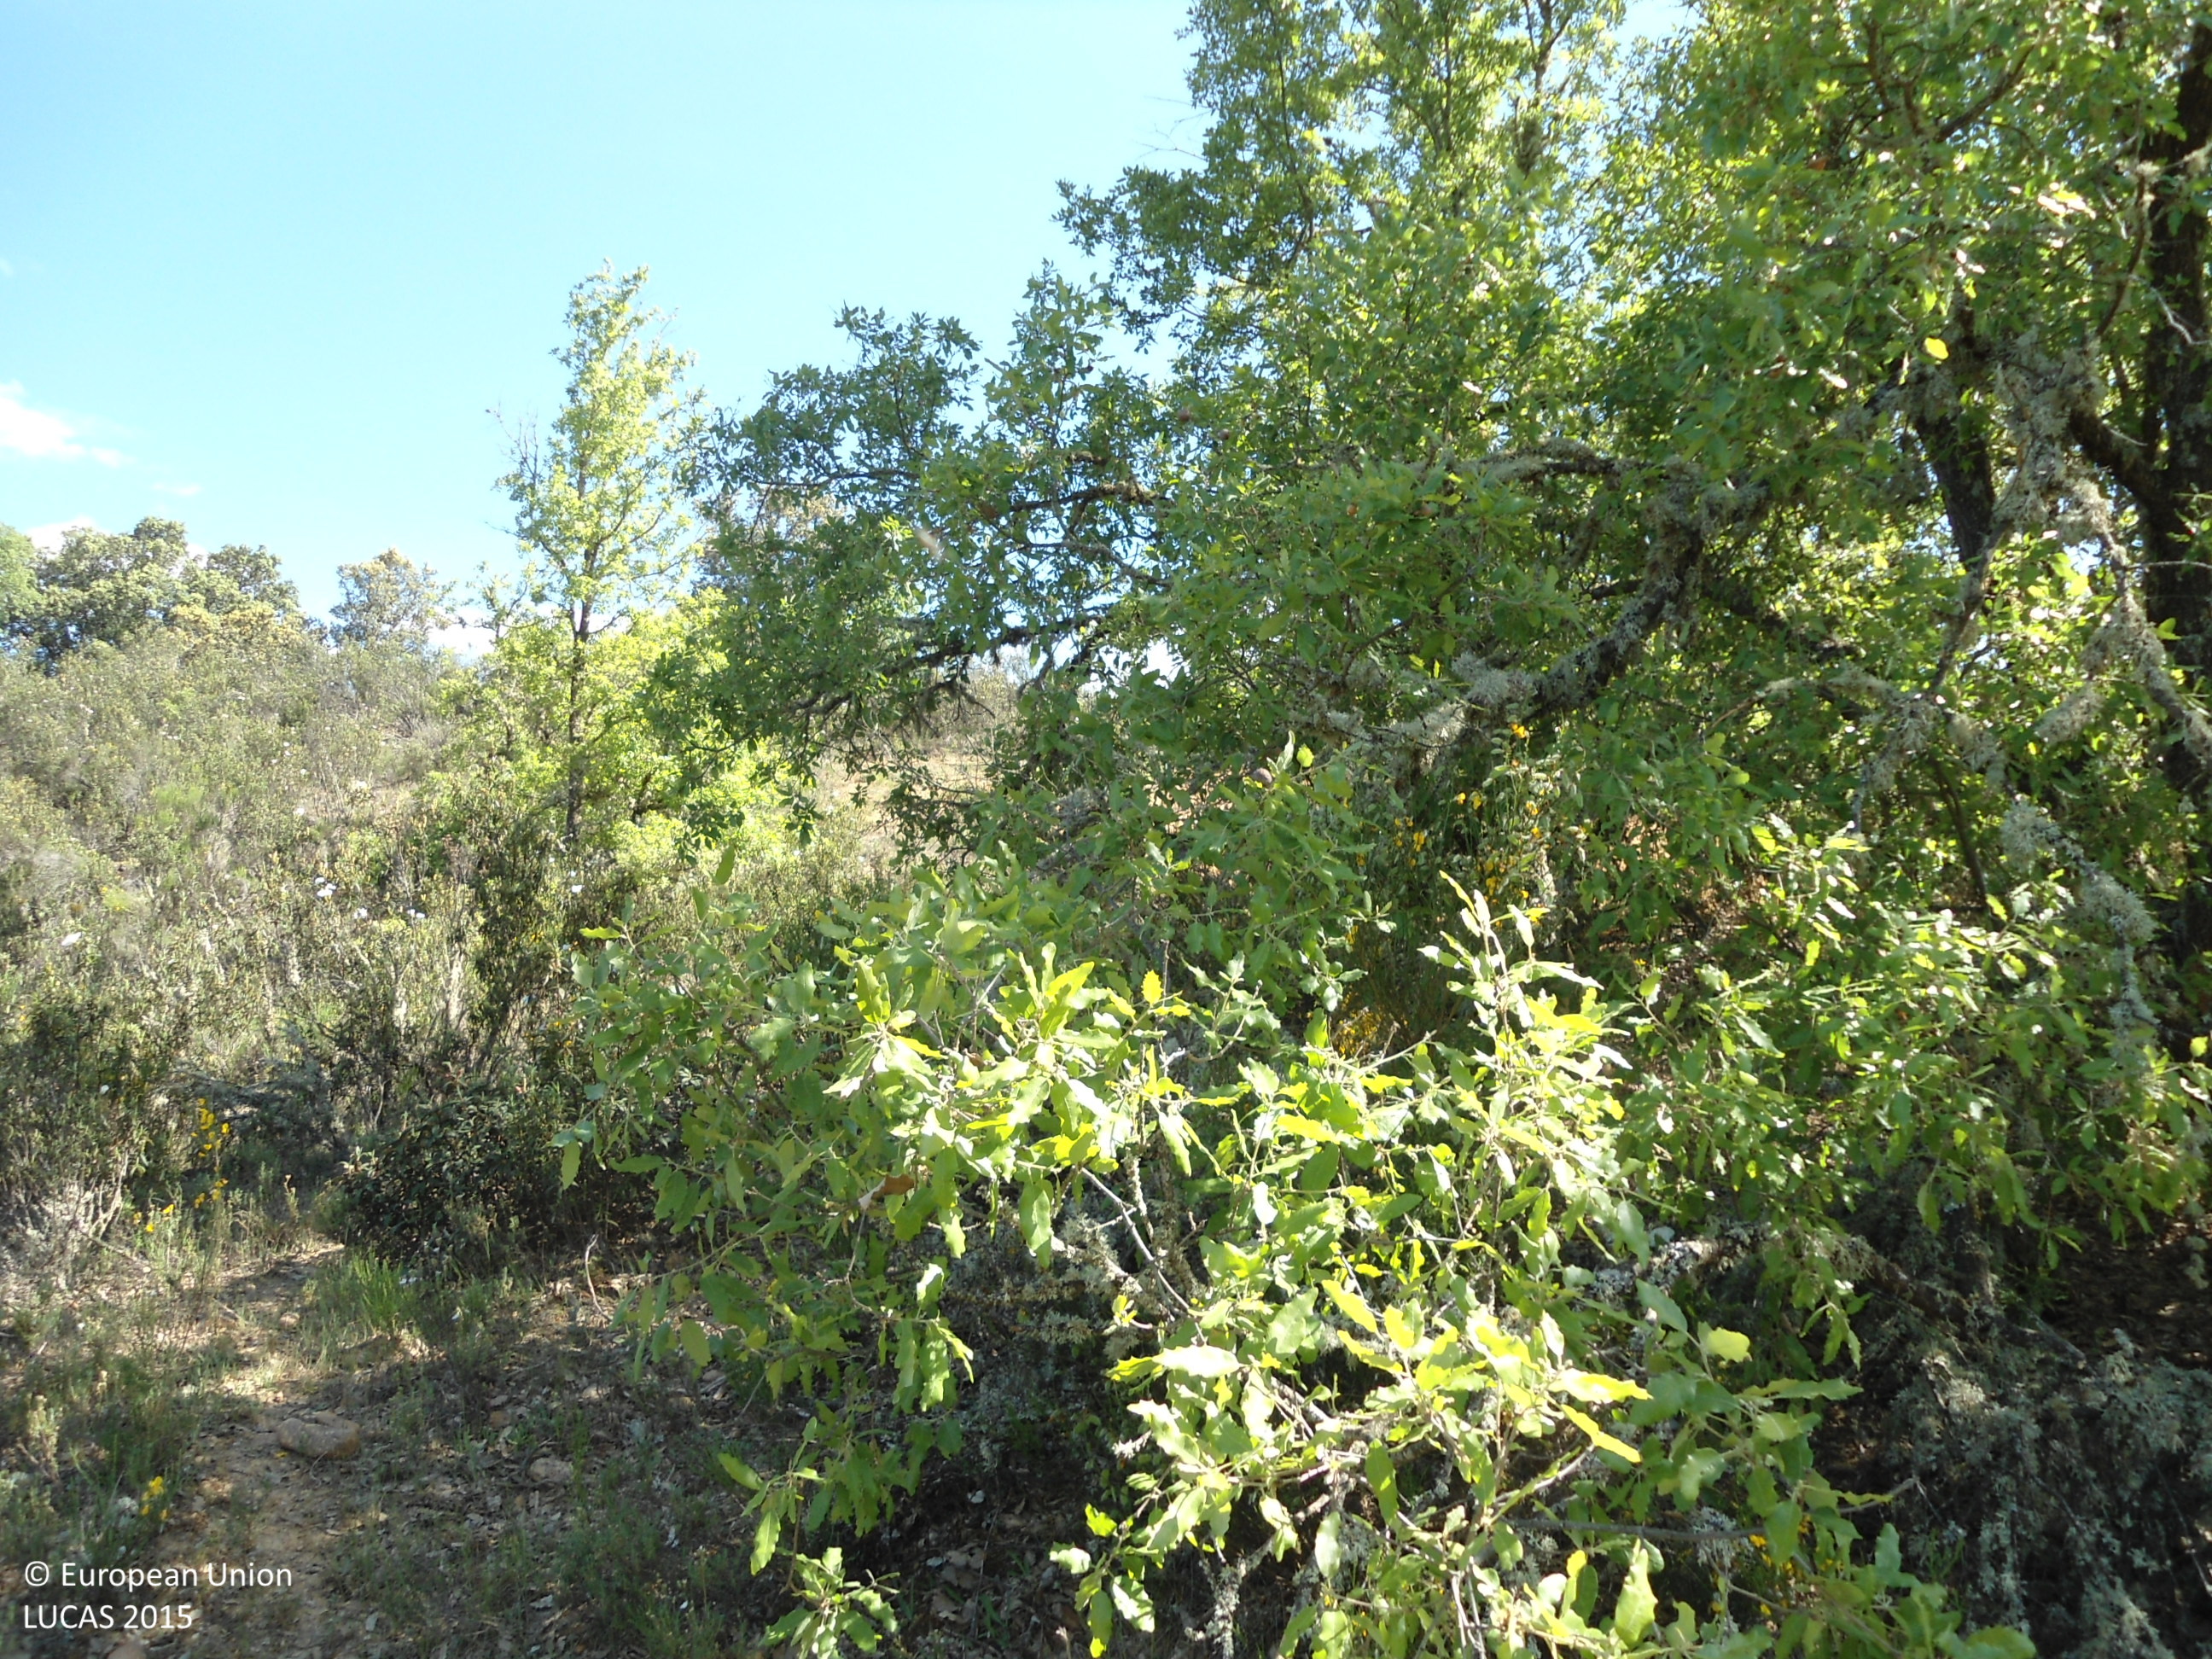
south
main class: Woodland
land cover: Broadleaved woodland
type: acidophilous oak and oak-birch forest
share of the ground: > 75 %
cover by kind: broadleaved forest trees 70 %, shrubs 30 %
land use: Semi-natural and natural areas not in use
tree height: > 5 m
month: May
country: ES
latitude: 41.9448
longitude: -5.9836
